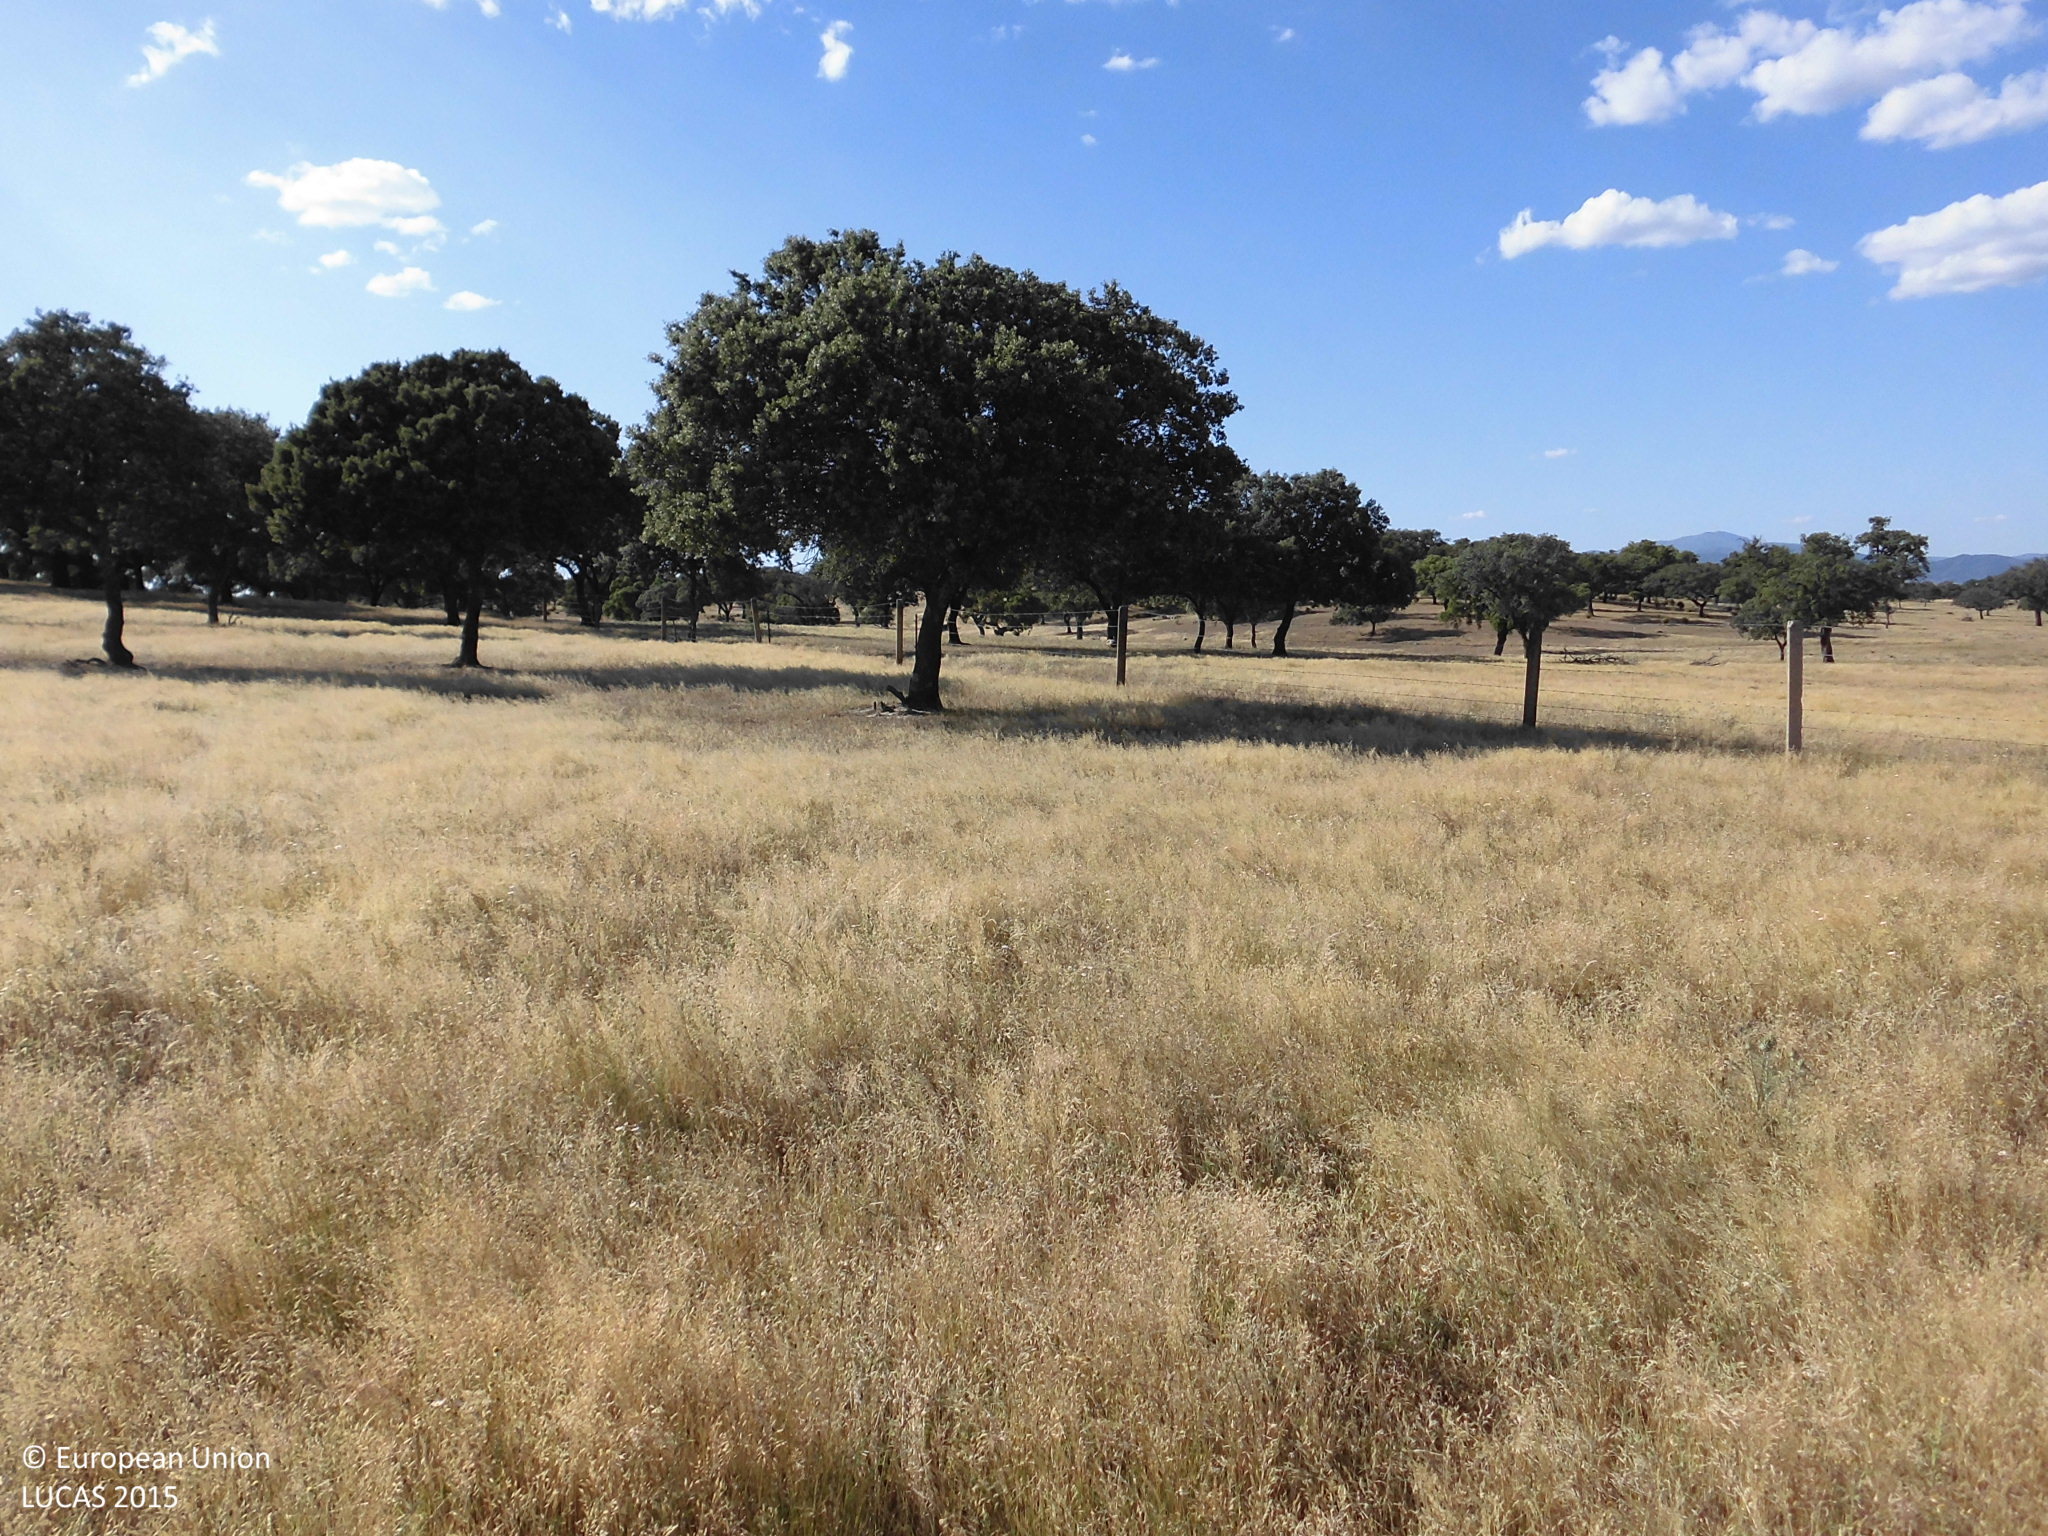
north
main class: Grassland
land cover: Grassland with sparse tree/shrub cover
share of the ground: > 75 %
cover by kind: herbaceous plants 95 %, broadleaved forest trees 5 %
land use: Agriculture (excluding fallow land and kitchen gardens)
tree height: > 5 m
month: May
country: ES
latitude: 39.9774
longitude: -6.7469
